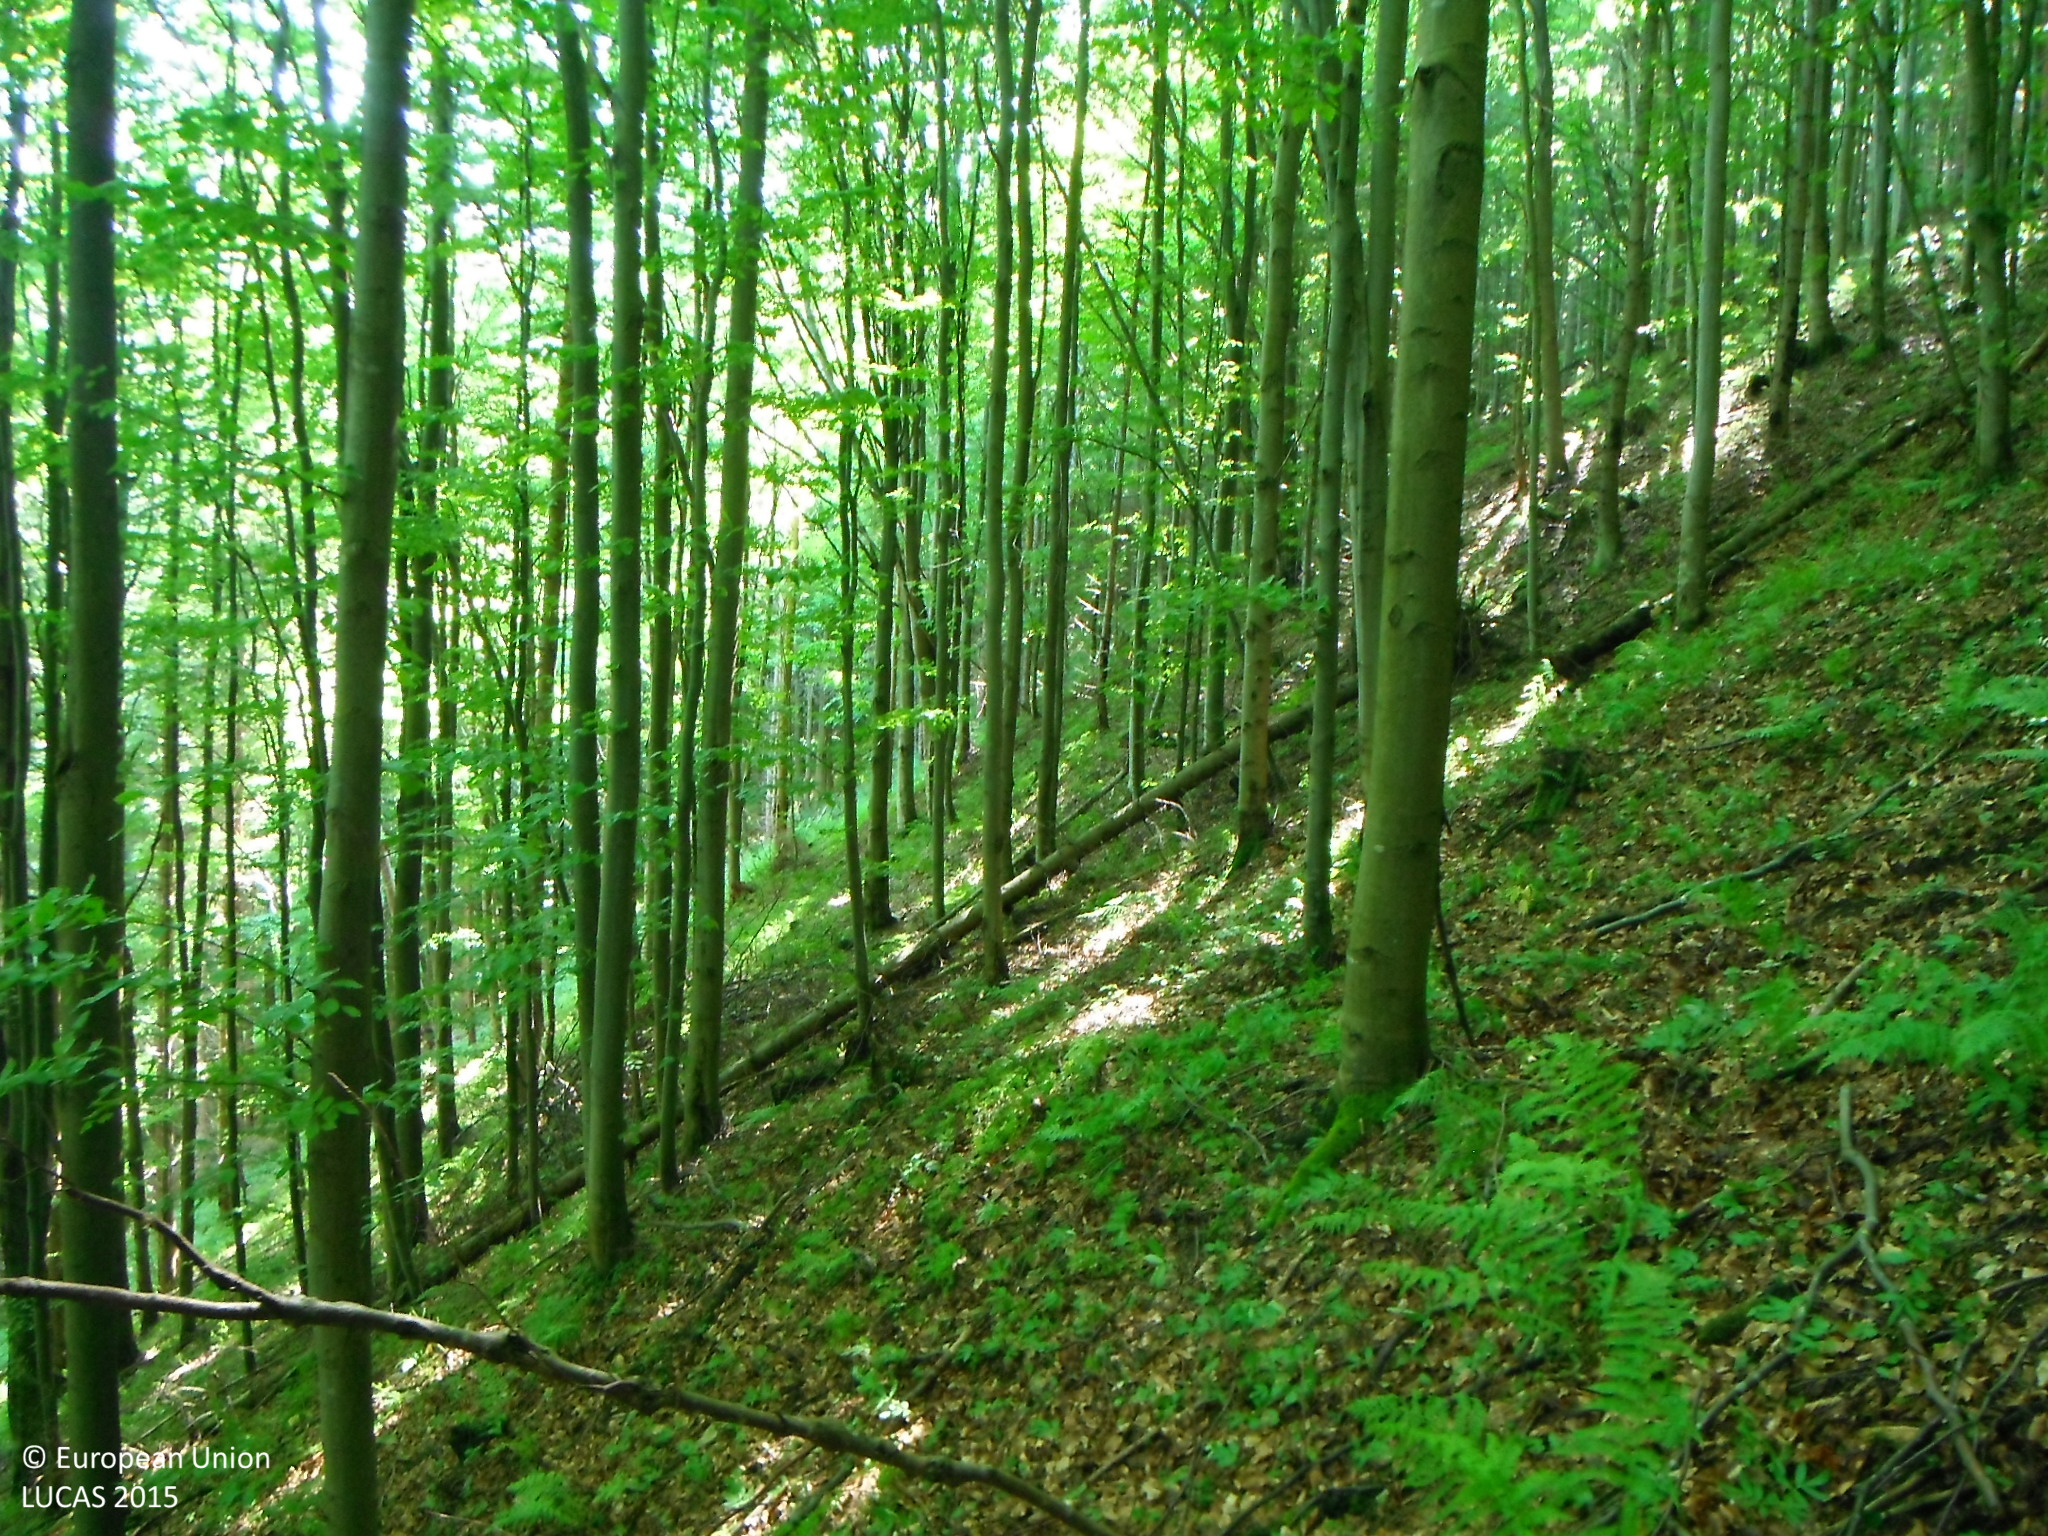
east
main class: Woodland
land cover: Broadleaved woodland
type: hemiboreal forest and nemoral coniferous forest and mixed broadleaved-coniferous forest
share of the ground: > 75 %
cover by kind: broadleaved forest trees 95 %, coniferous forest trees 5 %
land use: Forestry
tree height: > 5 m
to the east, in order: Broadleaved woodland; Spruce dominated mixed woodland; Broadleaved woodland; Spruce dominated mixed woodland; Broadleaved woodland; Spruce dominated mixed woodland; Spruce dominated coniferous woodland; Broadleaved woodland; Spruce dominated mixed woodland
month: June
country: SK
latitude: 48.7613
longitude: 19.8370
